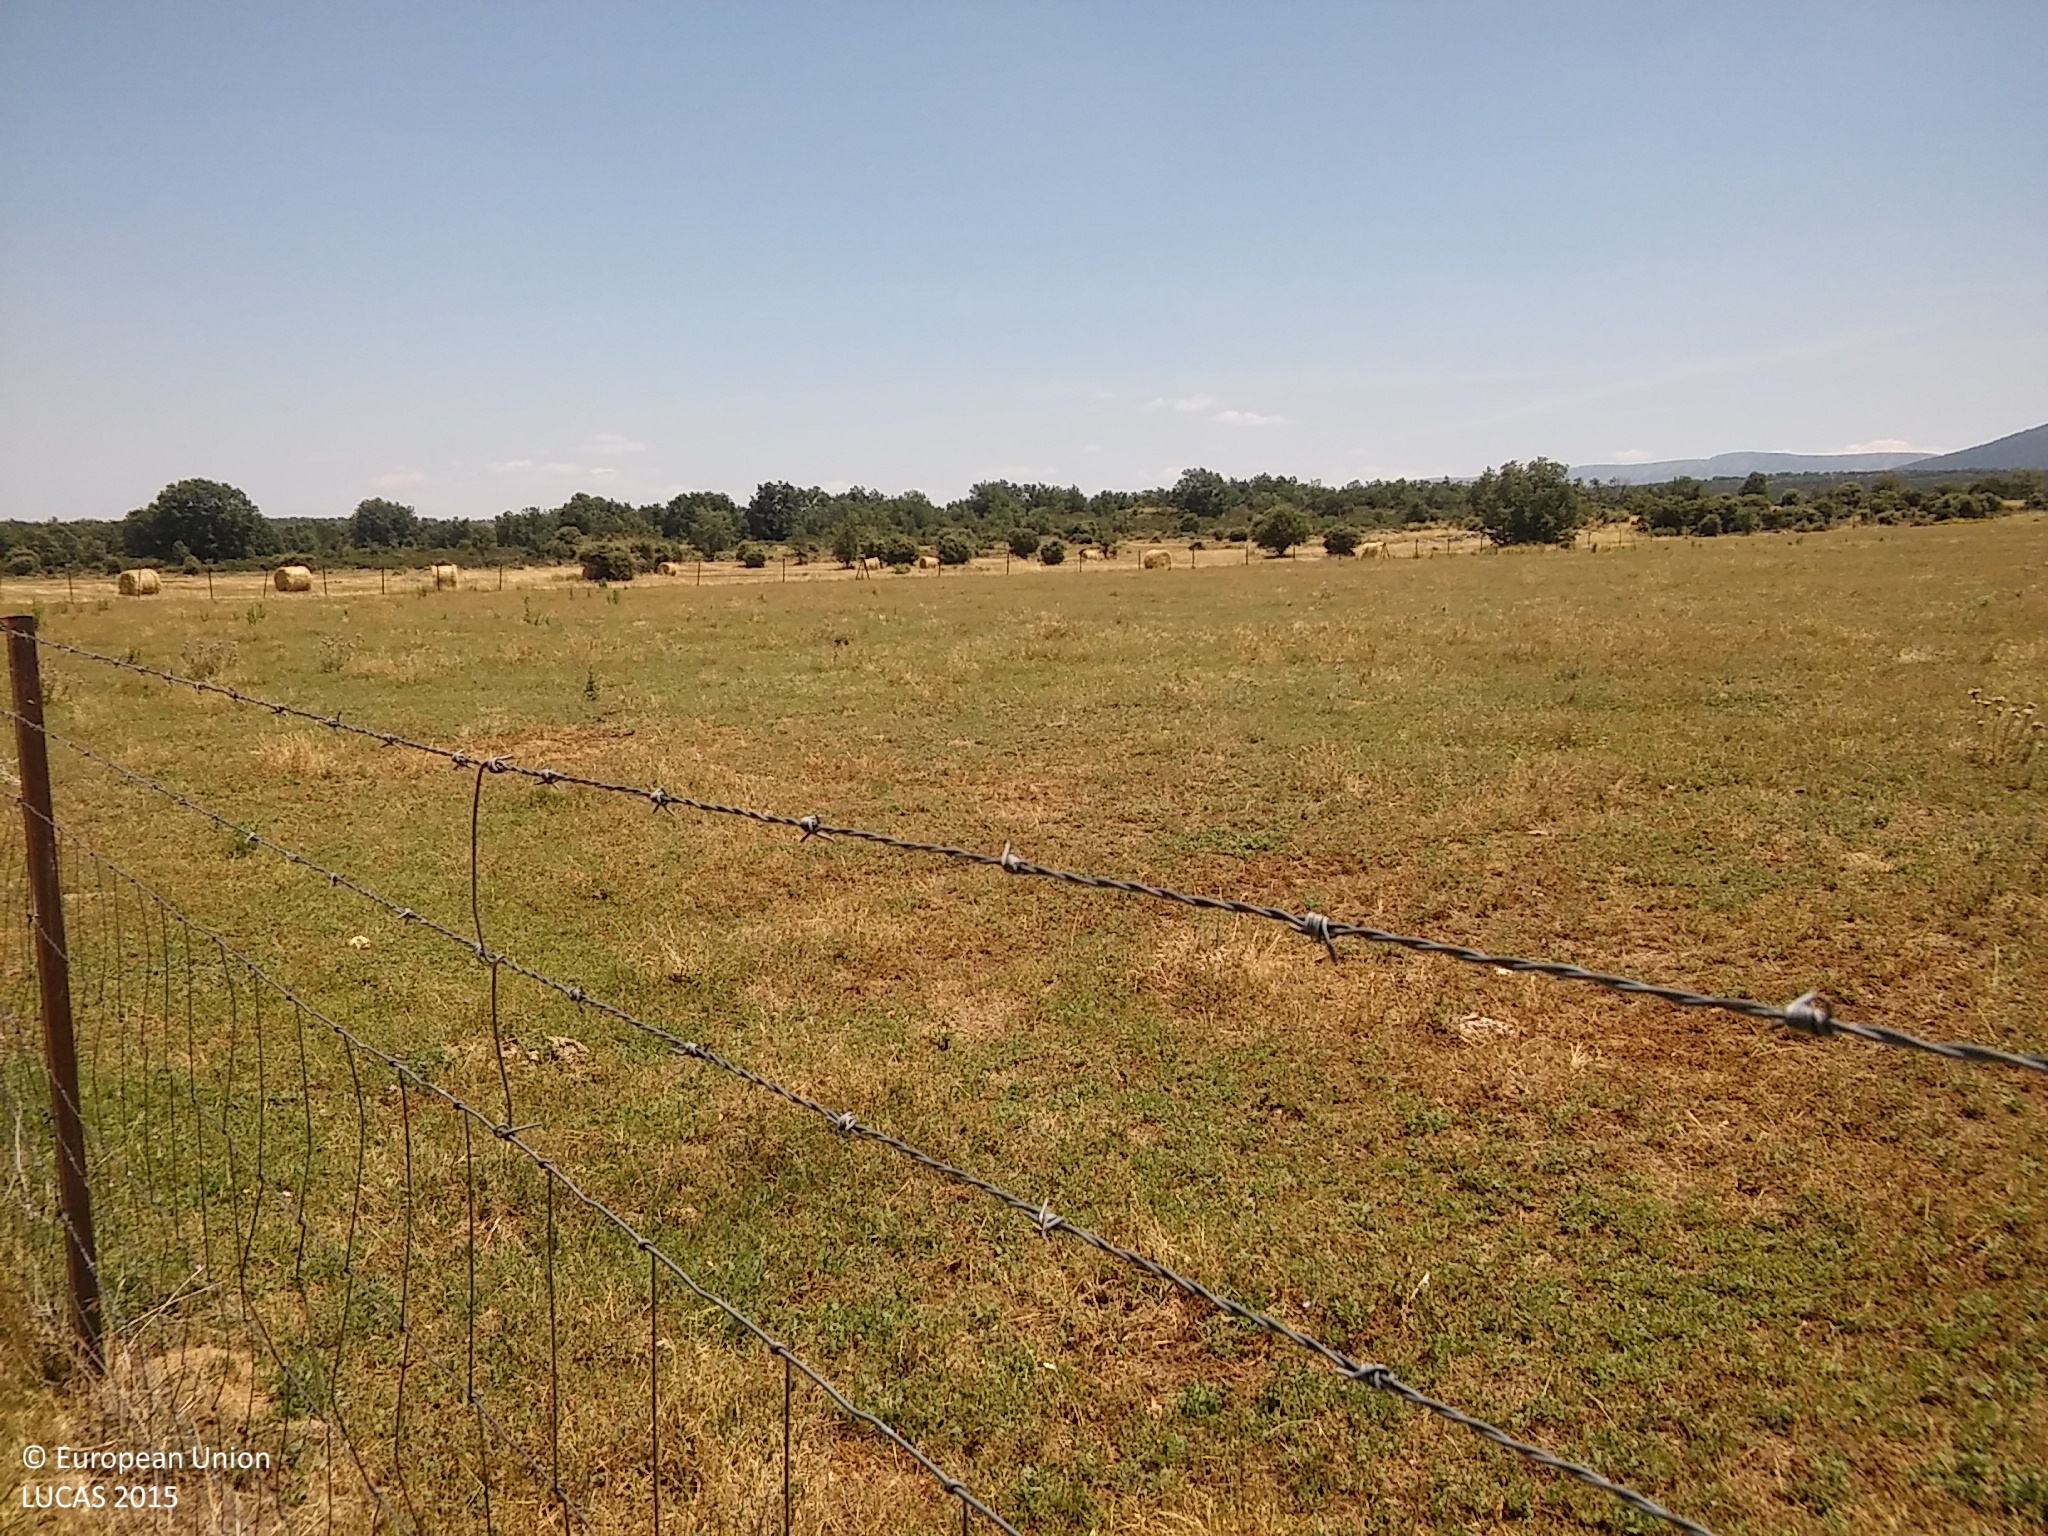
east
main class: Grassland
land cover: Grassland without tree/shrub cover
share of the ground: > 75 %
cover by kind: herbaceous plants 100 %
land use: Agriculture (excluding fallow land and kitchen gardens)
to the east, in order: Grassland without tree/shrub cover; Fences; Rye; Groves; Rye; Rock outcrops; Shrubland without tree cover; Rock outcrops; Shrubland without tree cover
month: June
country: ES
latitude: 41.0806
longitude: -3.9401
